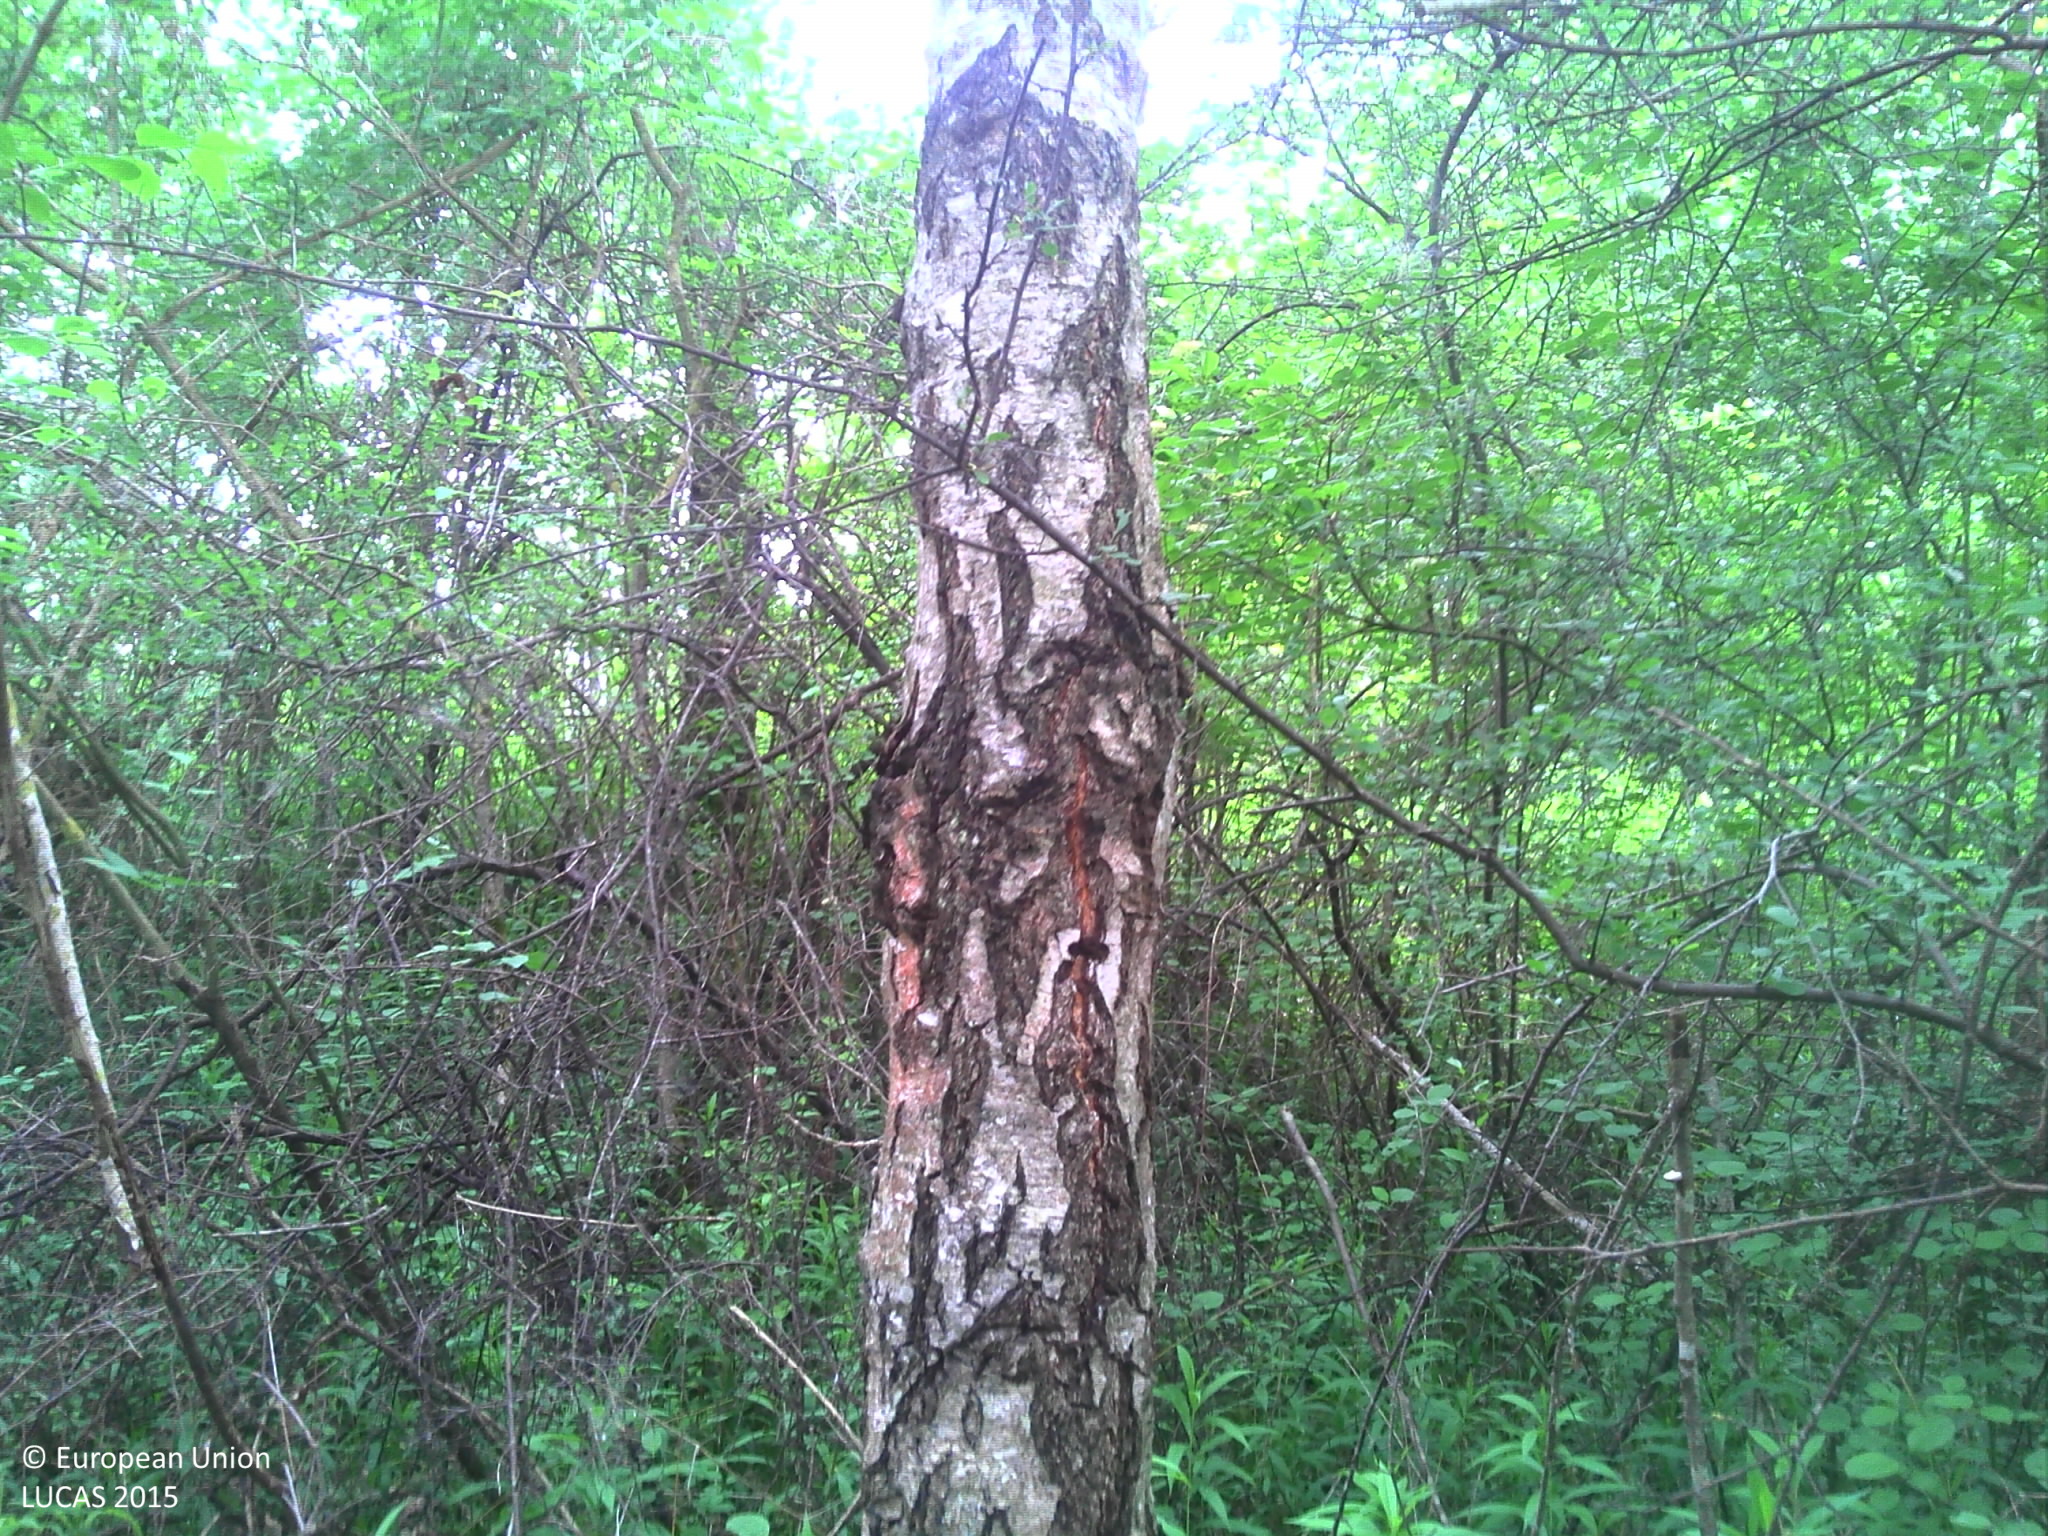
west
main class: Woodland
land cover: Broadleaved woodland
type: mesophytic deciduous forest
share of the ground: > 75 %
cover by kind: broadleaved forest trees 80 %, herbaceous plants 20 %
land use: Forestry
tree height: > 5 m
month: June
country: FR
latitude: 47.9089
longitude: 7.5797
